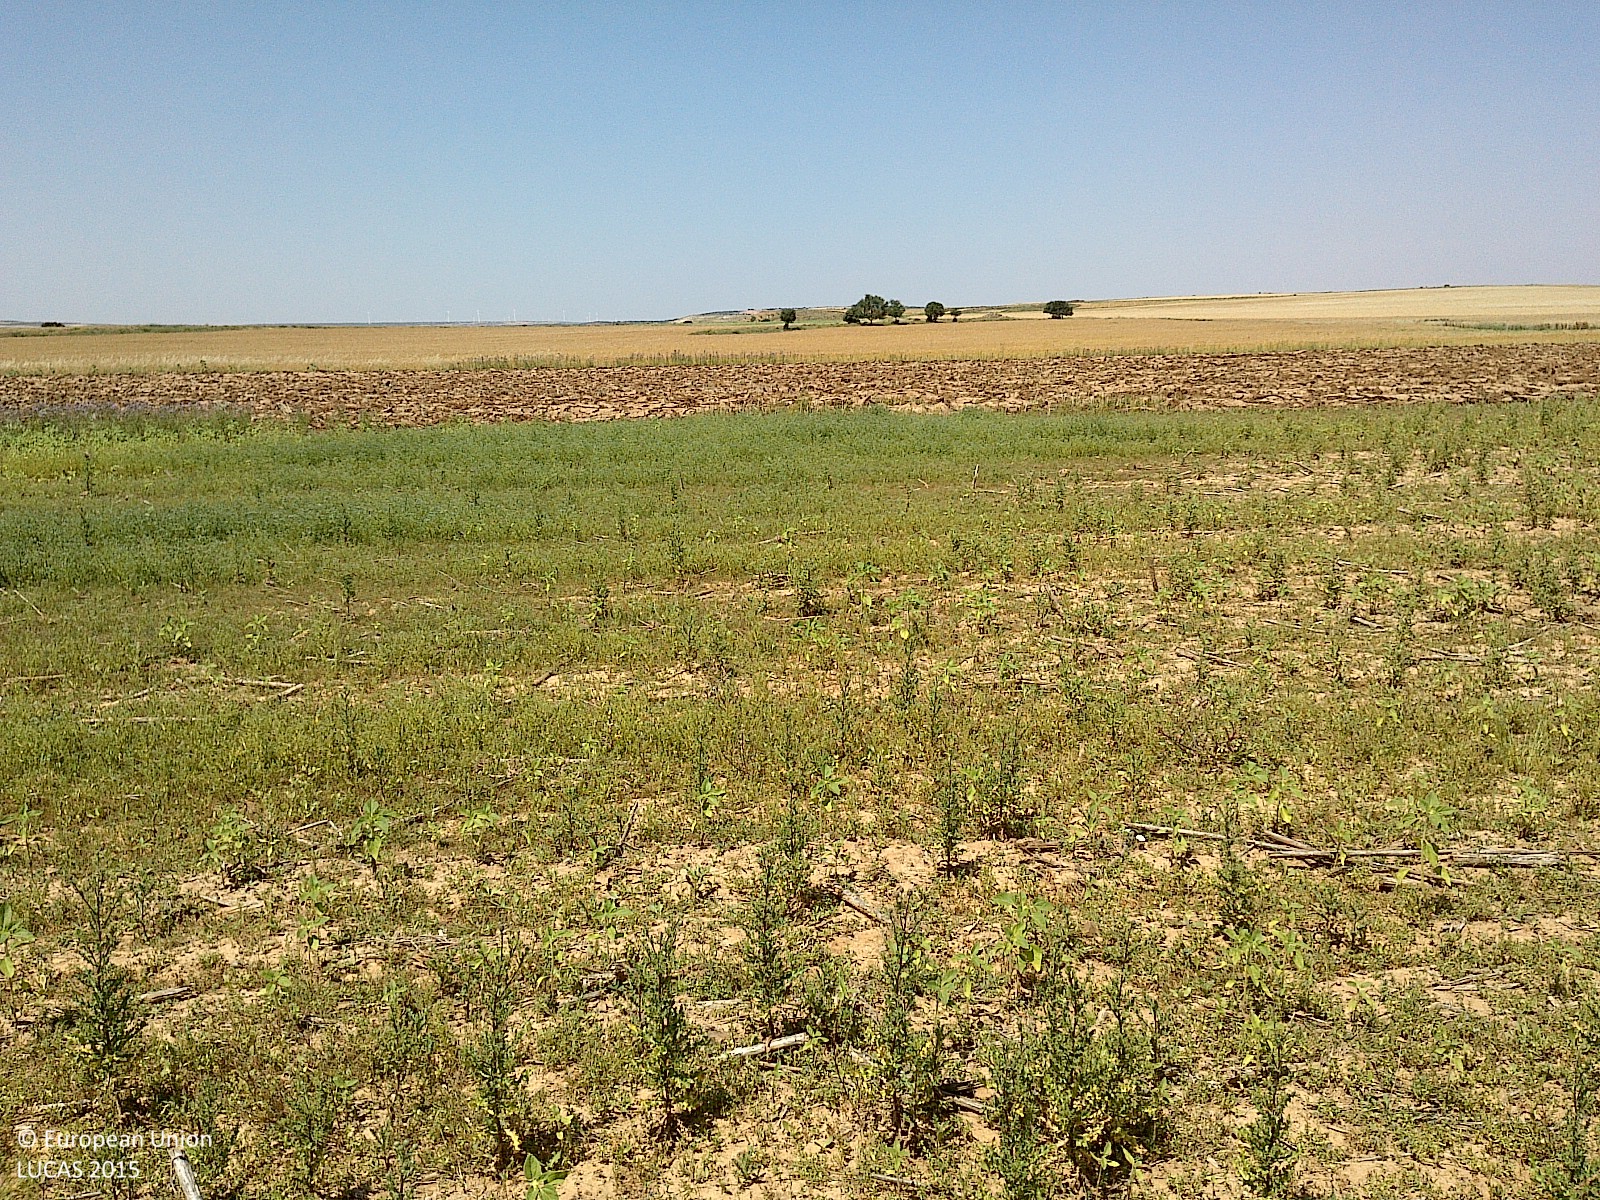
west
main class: Grassland
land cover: Spontaneously vegetated surfaces
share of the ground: > 75 %
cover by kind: herbaceous plants 75 %, unconsolidated bare surface 25 %
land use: Fallow land
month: July
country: ES
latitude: 41.5779
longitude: -2.1099
